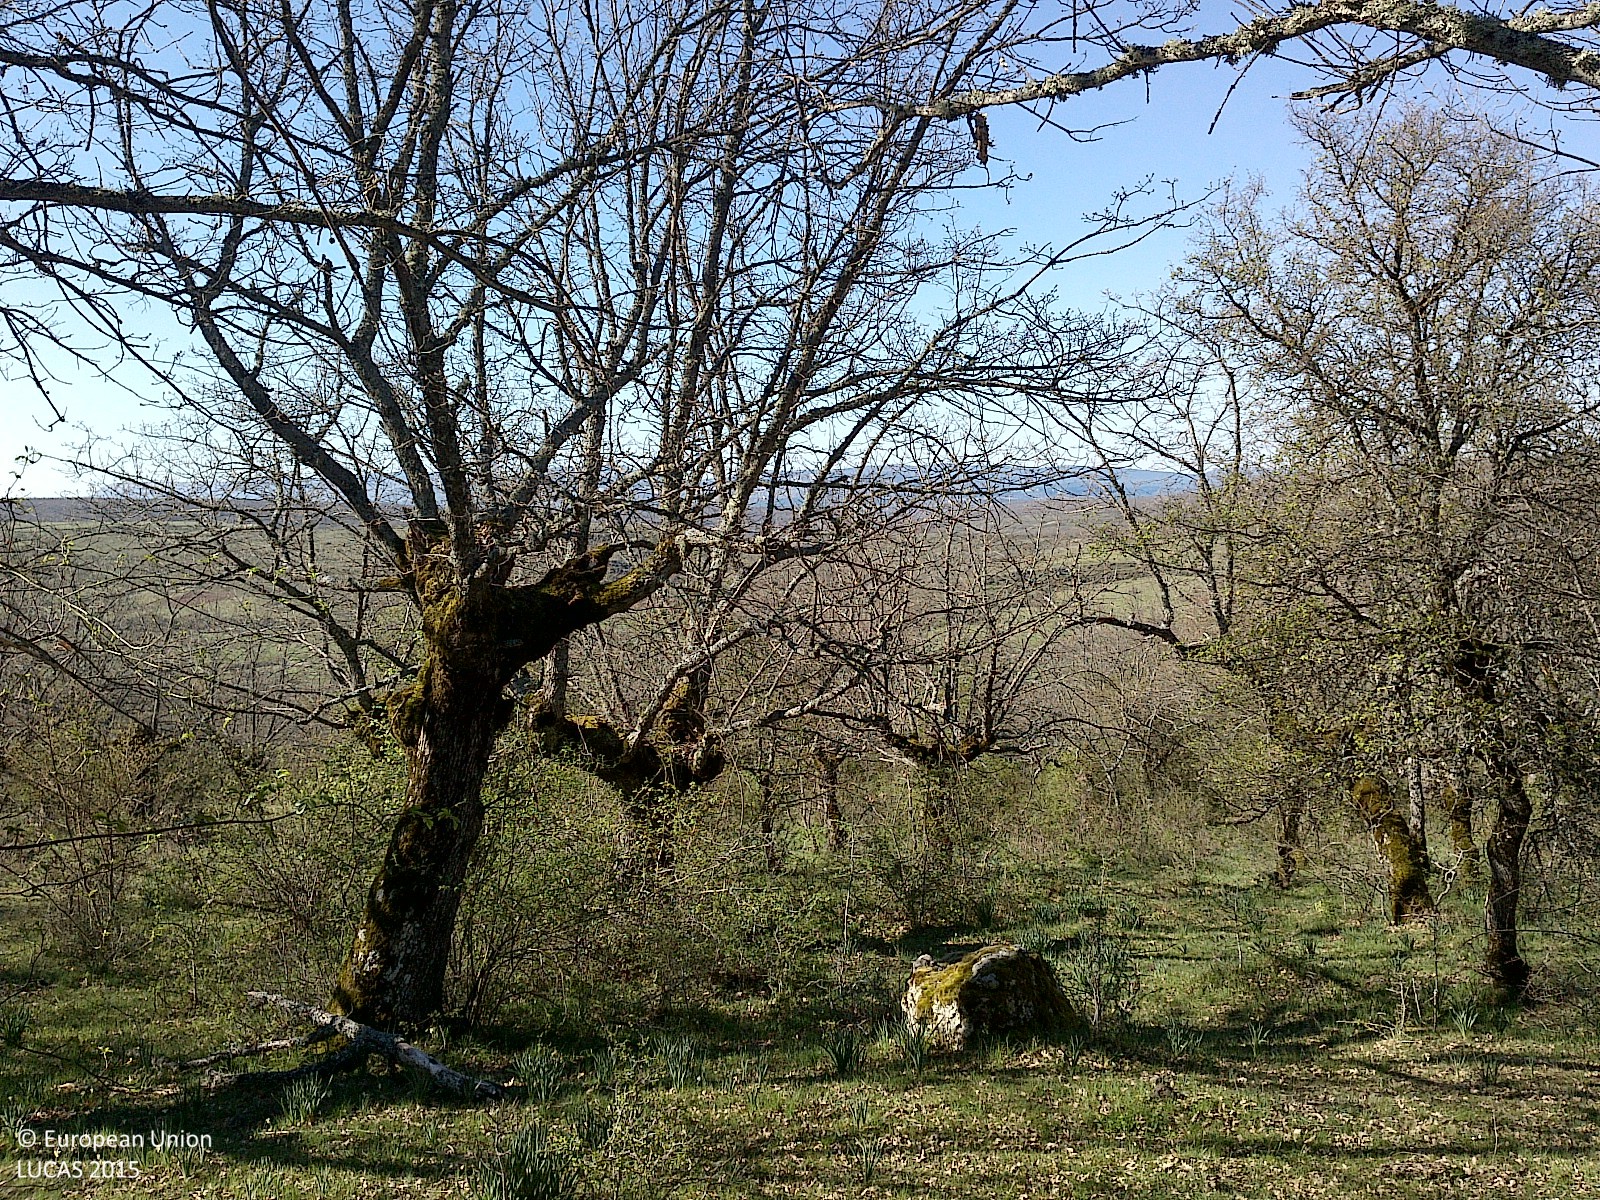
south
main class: Woodland
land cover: Broadleaved woodland
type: thermophilous deciduous forest
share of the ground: 25 - 50 %
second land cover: Grassland without tree/shrub cover
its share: > 75 %
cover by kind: herbaceous plants 55 %, broadleaved forest trees 35 %, shrubs 10 %
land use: Forestry
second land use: Agriculture (excluding fallow land and kitchen gardens)
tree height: > 5 m
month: April
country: ES
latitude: 42.1494
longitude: -3.3525
